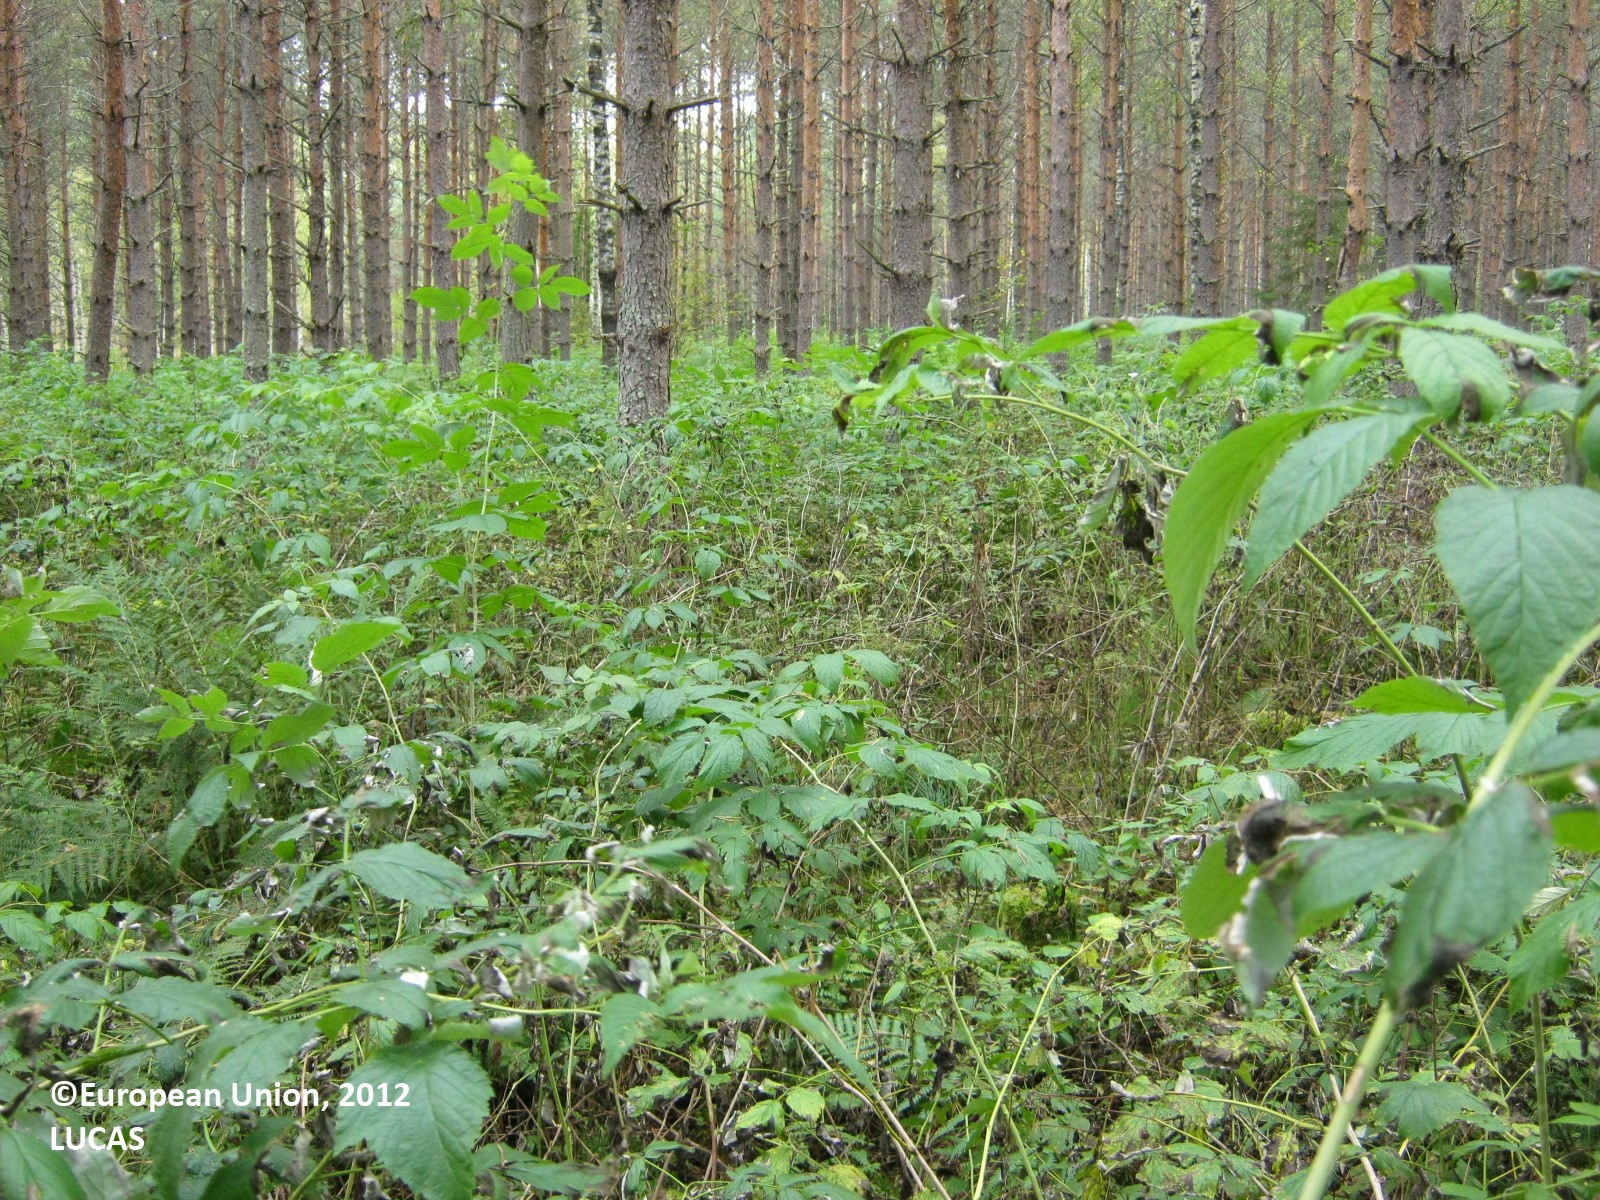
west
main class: Woodland
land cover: Spruce dominated mixed woodland
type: boreal forest
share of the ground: > 75 %
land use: Forestry
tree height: > 5 m
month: September
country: FI
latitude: 60.6845
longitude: 27.7902
